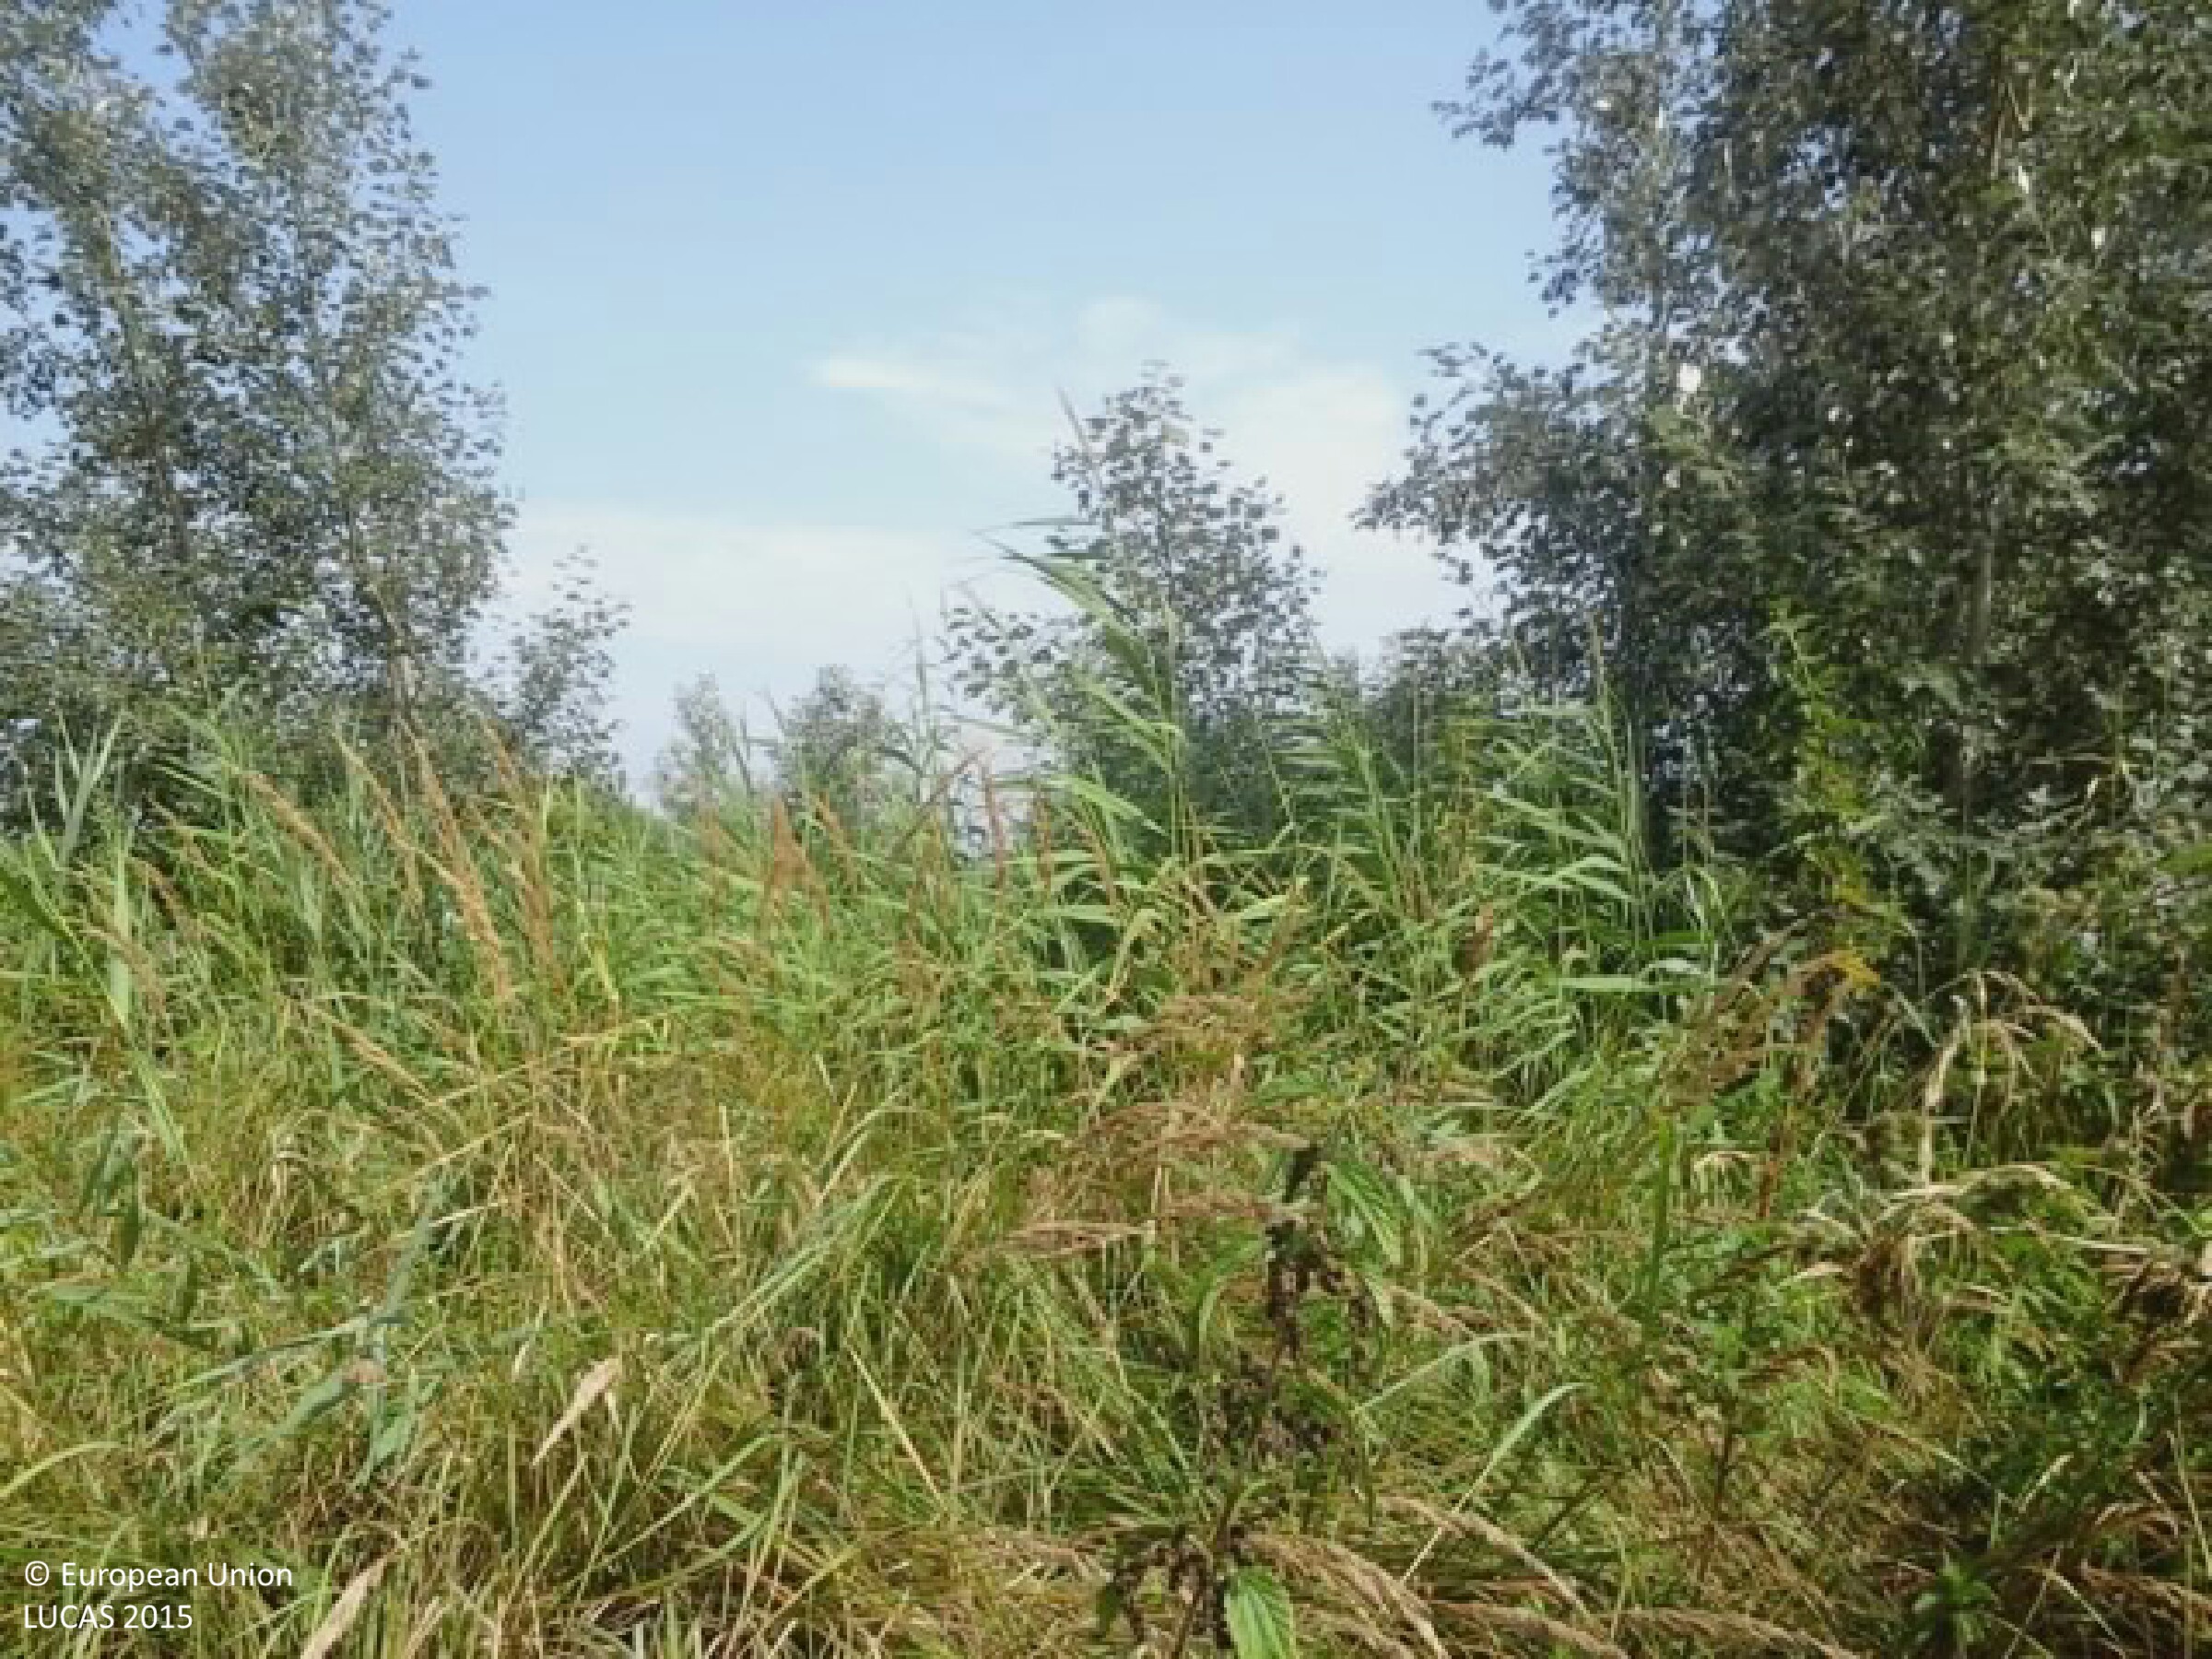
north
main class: Grassland
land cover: Spontaneously vegetated surfaces
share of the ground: > 75 %
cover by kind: herbaceous plants 100 %
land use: Fallow land
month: August
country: HU
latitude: 47.1744
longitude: 19.7463
